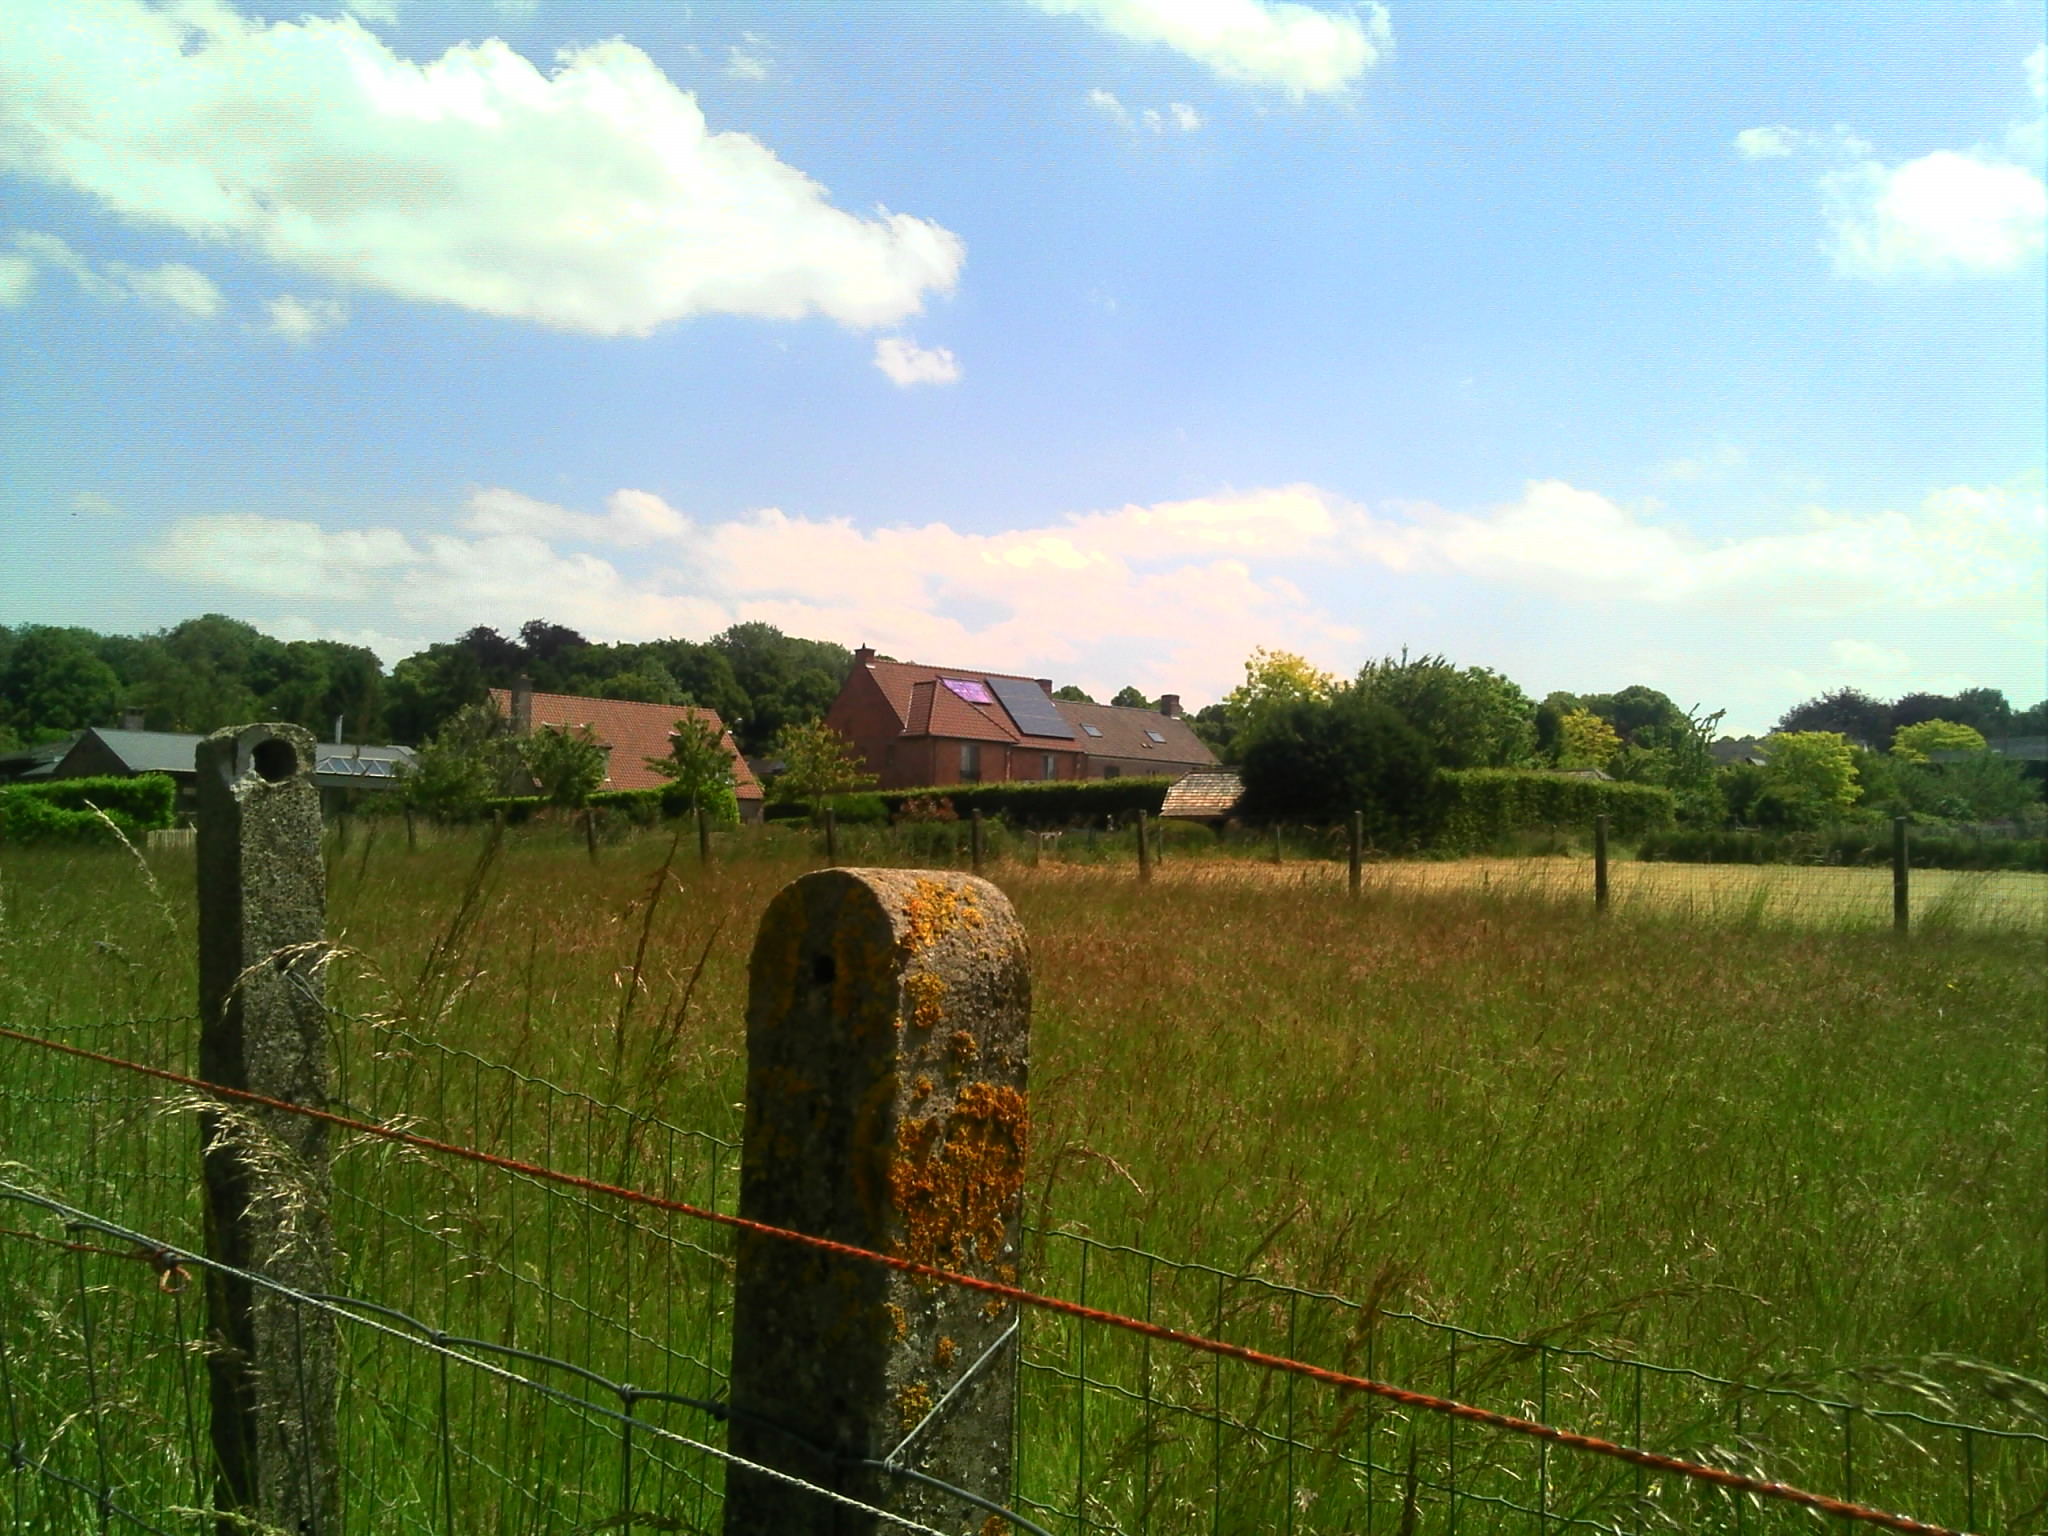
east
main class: Grassland
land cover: Grassland without tree/shrub cover
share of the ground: > 75 %
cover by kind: herbaceous plants 100 %
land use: Agriculture (excluding fallow land and kitchen gardens)
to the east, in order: Grassland without tree/shrub cover; Fences; Grassland without tree/shrub cover; Artificial constructions in urban areas; Grassland with sparse tree/shrub cover; Fences; Managed hedges; Lines of trees
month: June
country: BE
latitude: 50.9438
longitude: 4.3164
